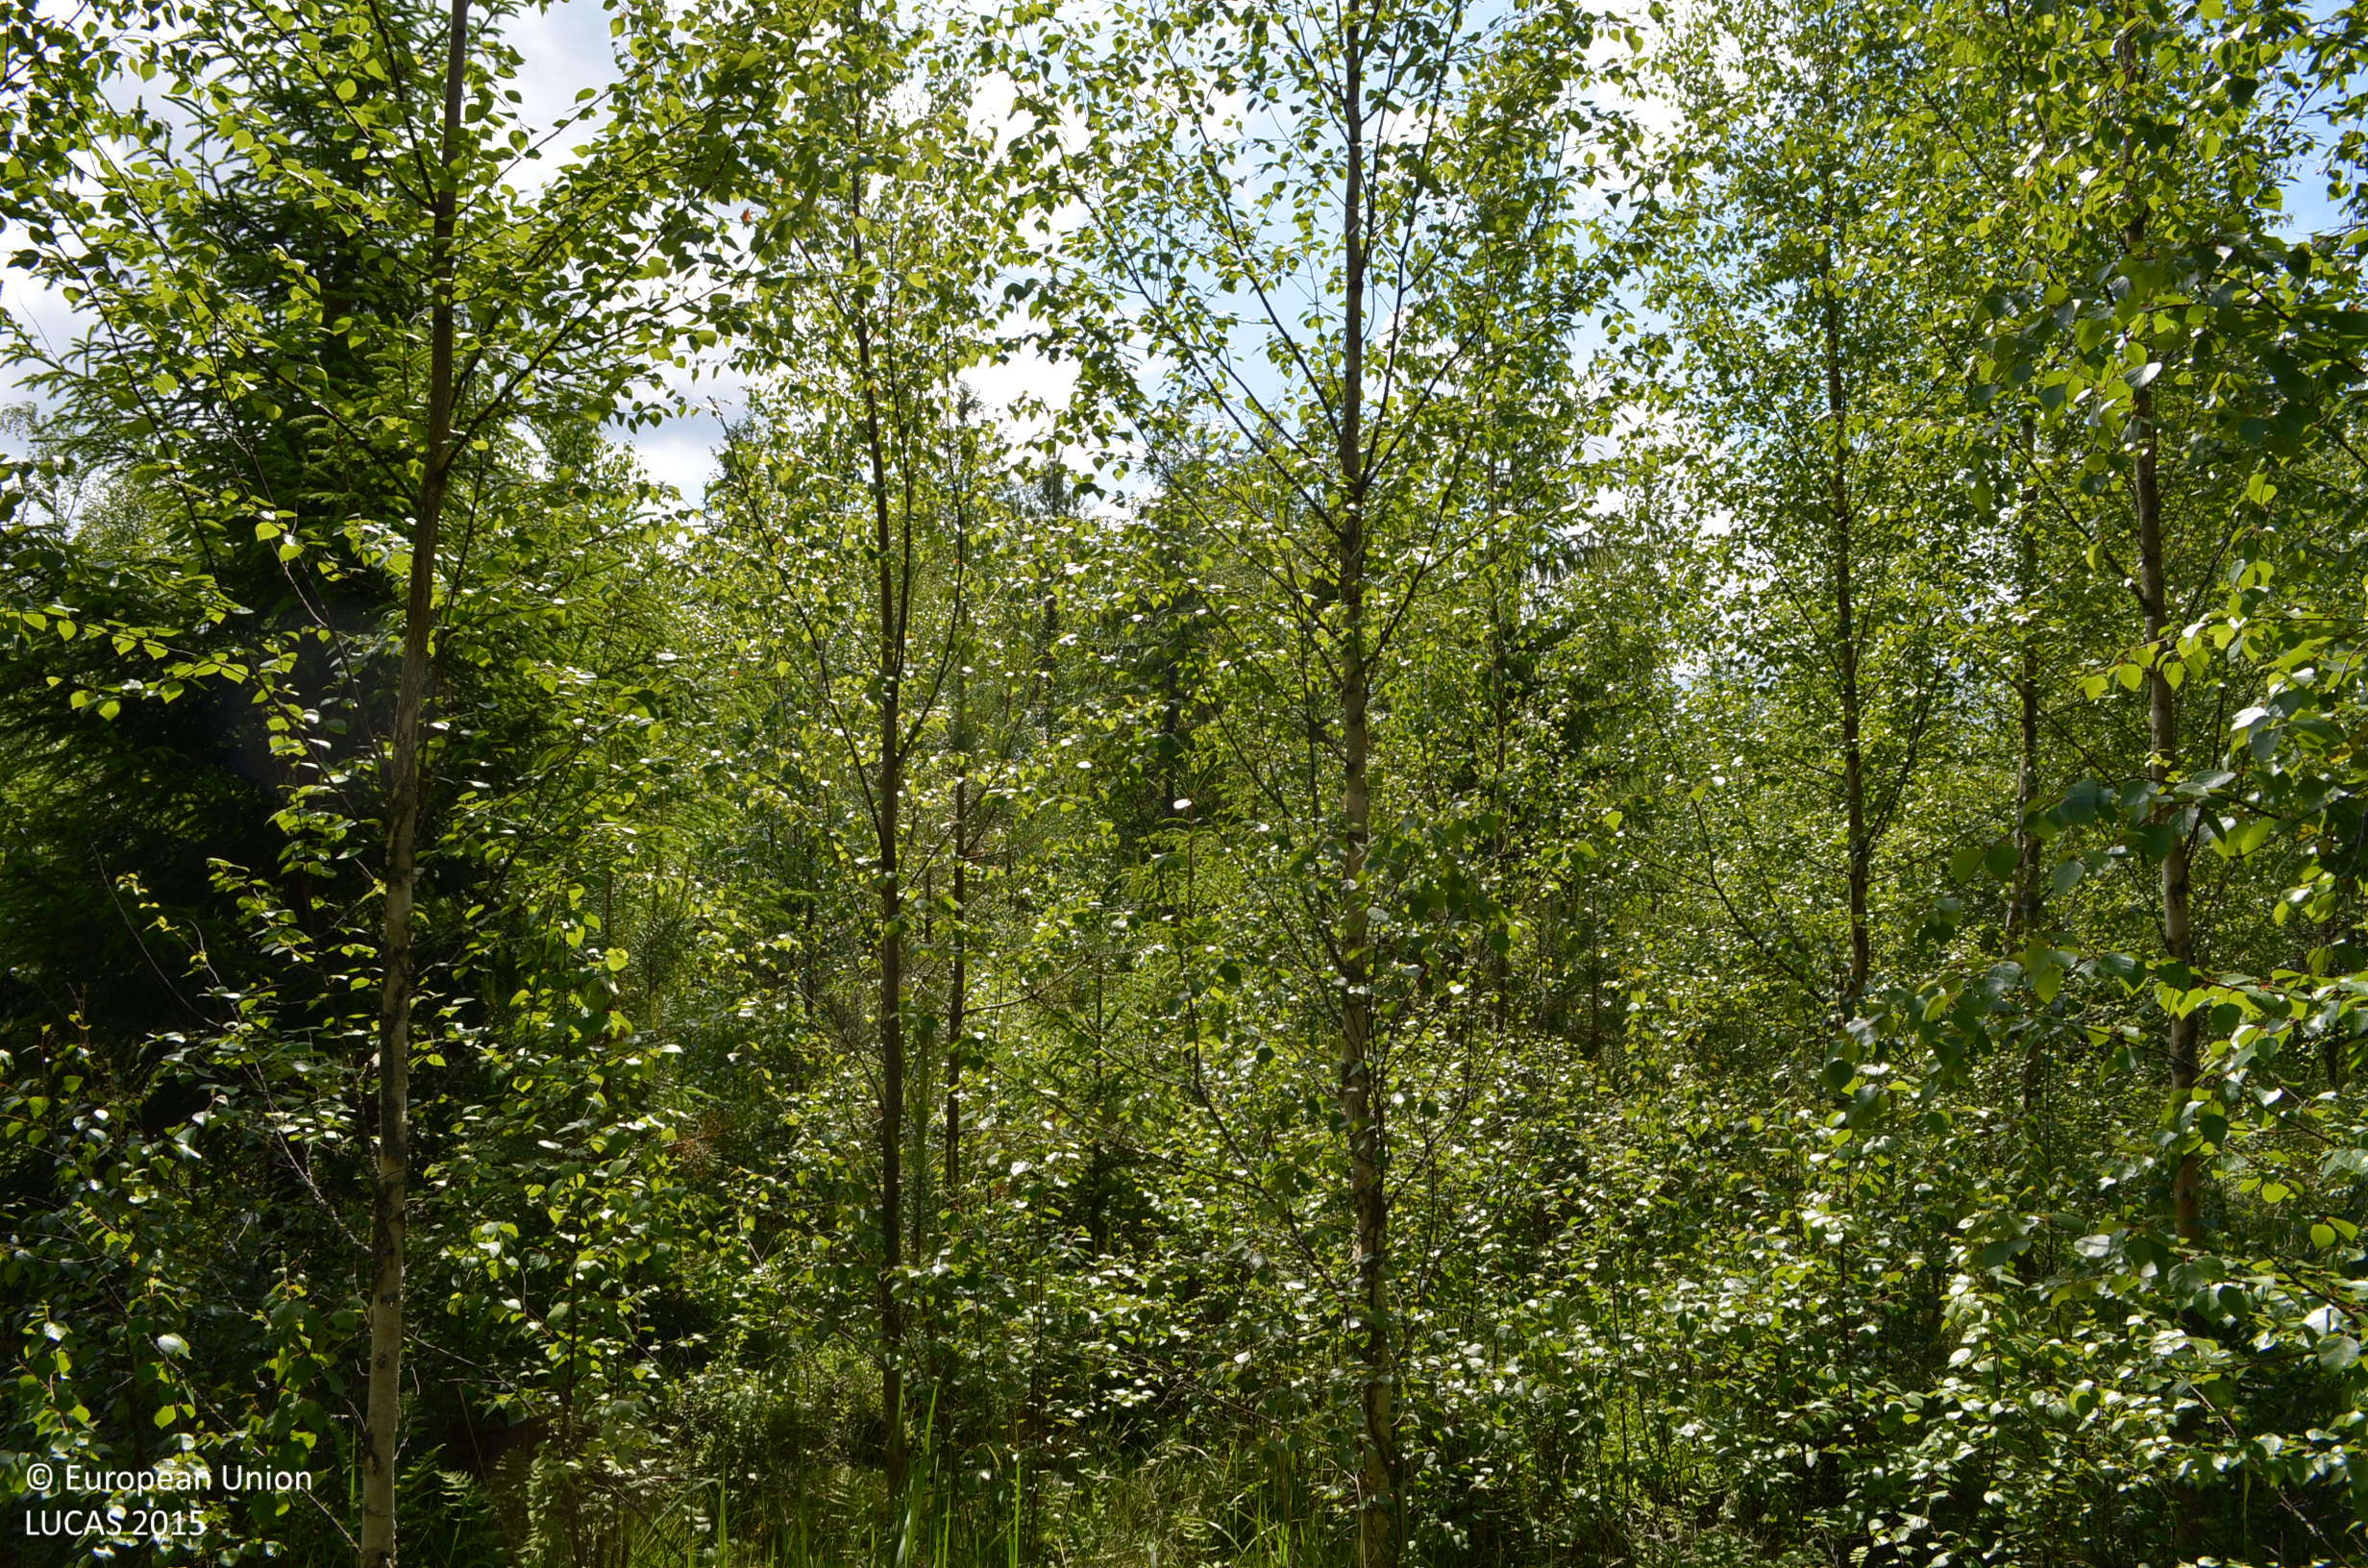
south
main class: Woodland
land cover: Other mixed woodland
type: boreal forest
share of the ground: > 75 %
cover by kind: broadleaved forest trees 40 %, coniferous forest trees 35 %, shrubs 20 %, herbaceous plants 5 %
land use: Forestry
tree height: < 5 m
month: June
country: FI
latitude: 61.6584
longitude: 23.2349
